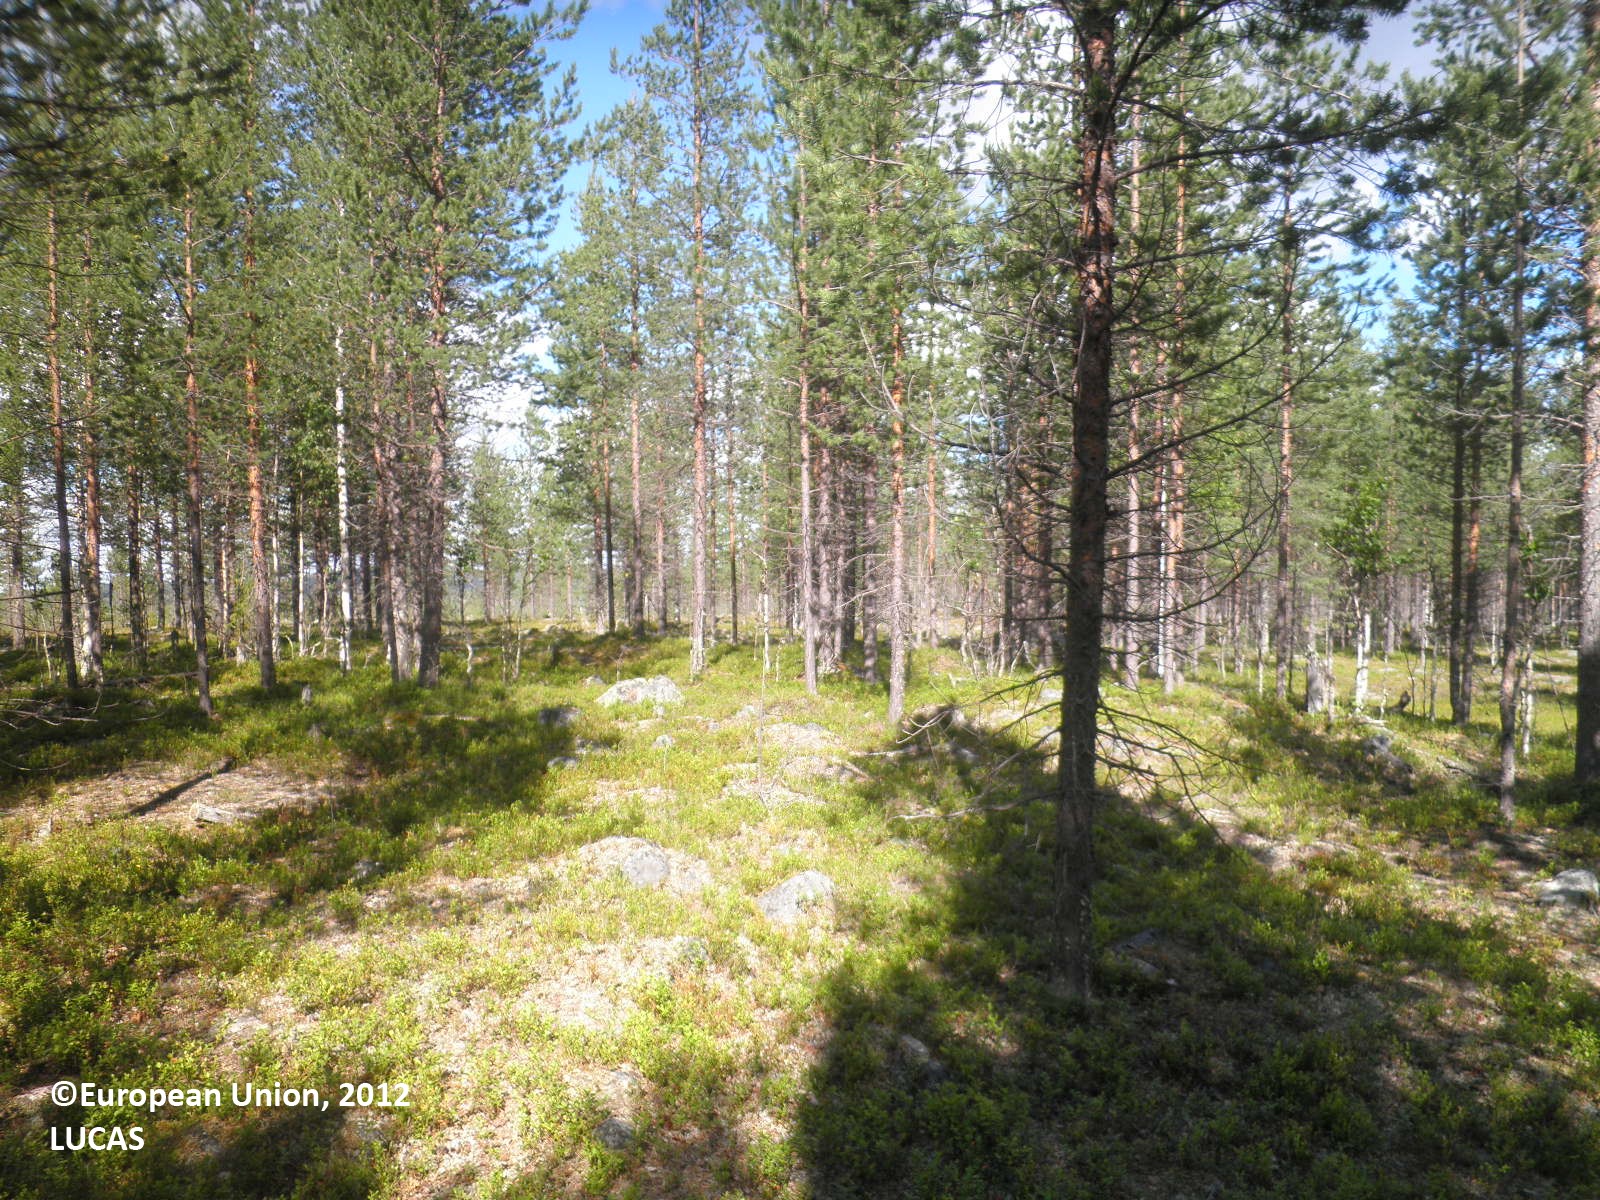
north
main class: Woodland
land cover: Pine dominated coniferous woodland
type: boreal forest
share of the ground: 50 - 75 %
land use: Forestry
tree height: > 5 m
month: August
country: FI
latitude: 67.1329
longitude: 28.9925
